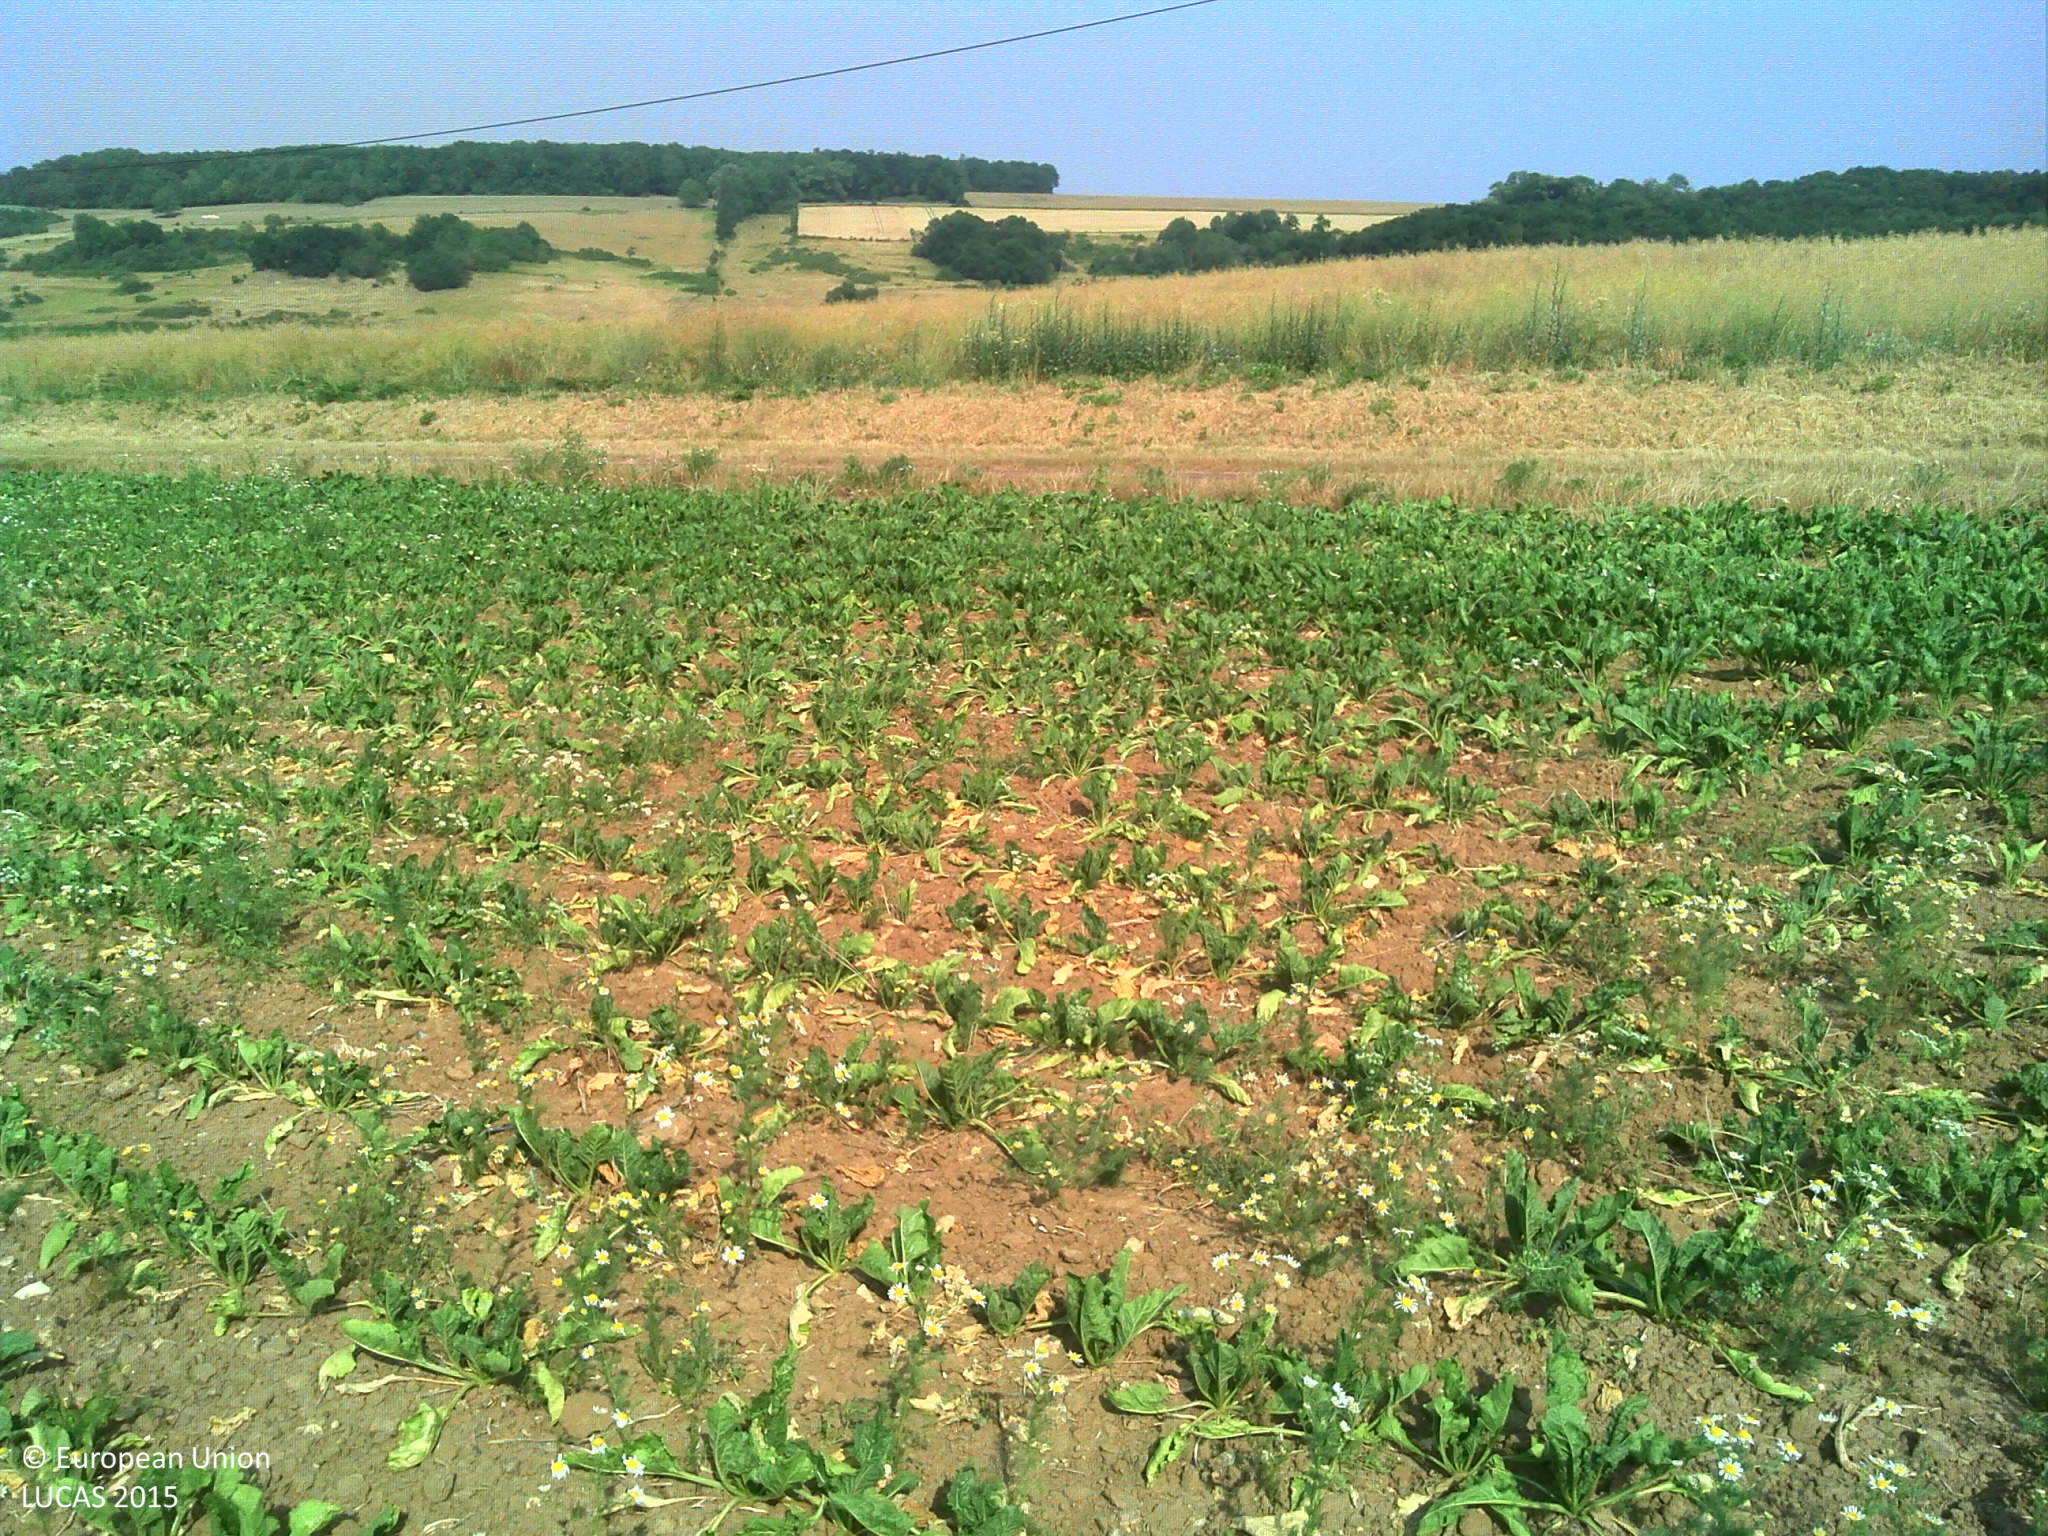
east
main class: Cropland
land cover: Sugar beet
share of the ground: 50 - 75 %
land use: Agriculture (excluding fallow land and kitchen gardens)
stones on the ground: < 10 %
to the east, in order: Sugar beet; Grass margins; Paved roads, cycling and walking lanes; Grass margins; Electric lines; Rape and turnip rape; Grass margins; Tracks; Grass margins; Potatoes
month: July
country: FR
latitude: 49.1595
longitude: 3.3418
